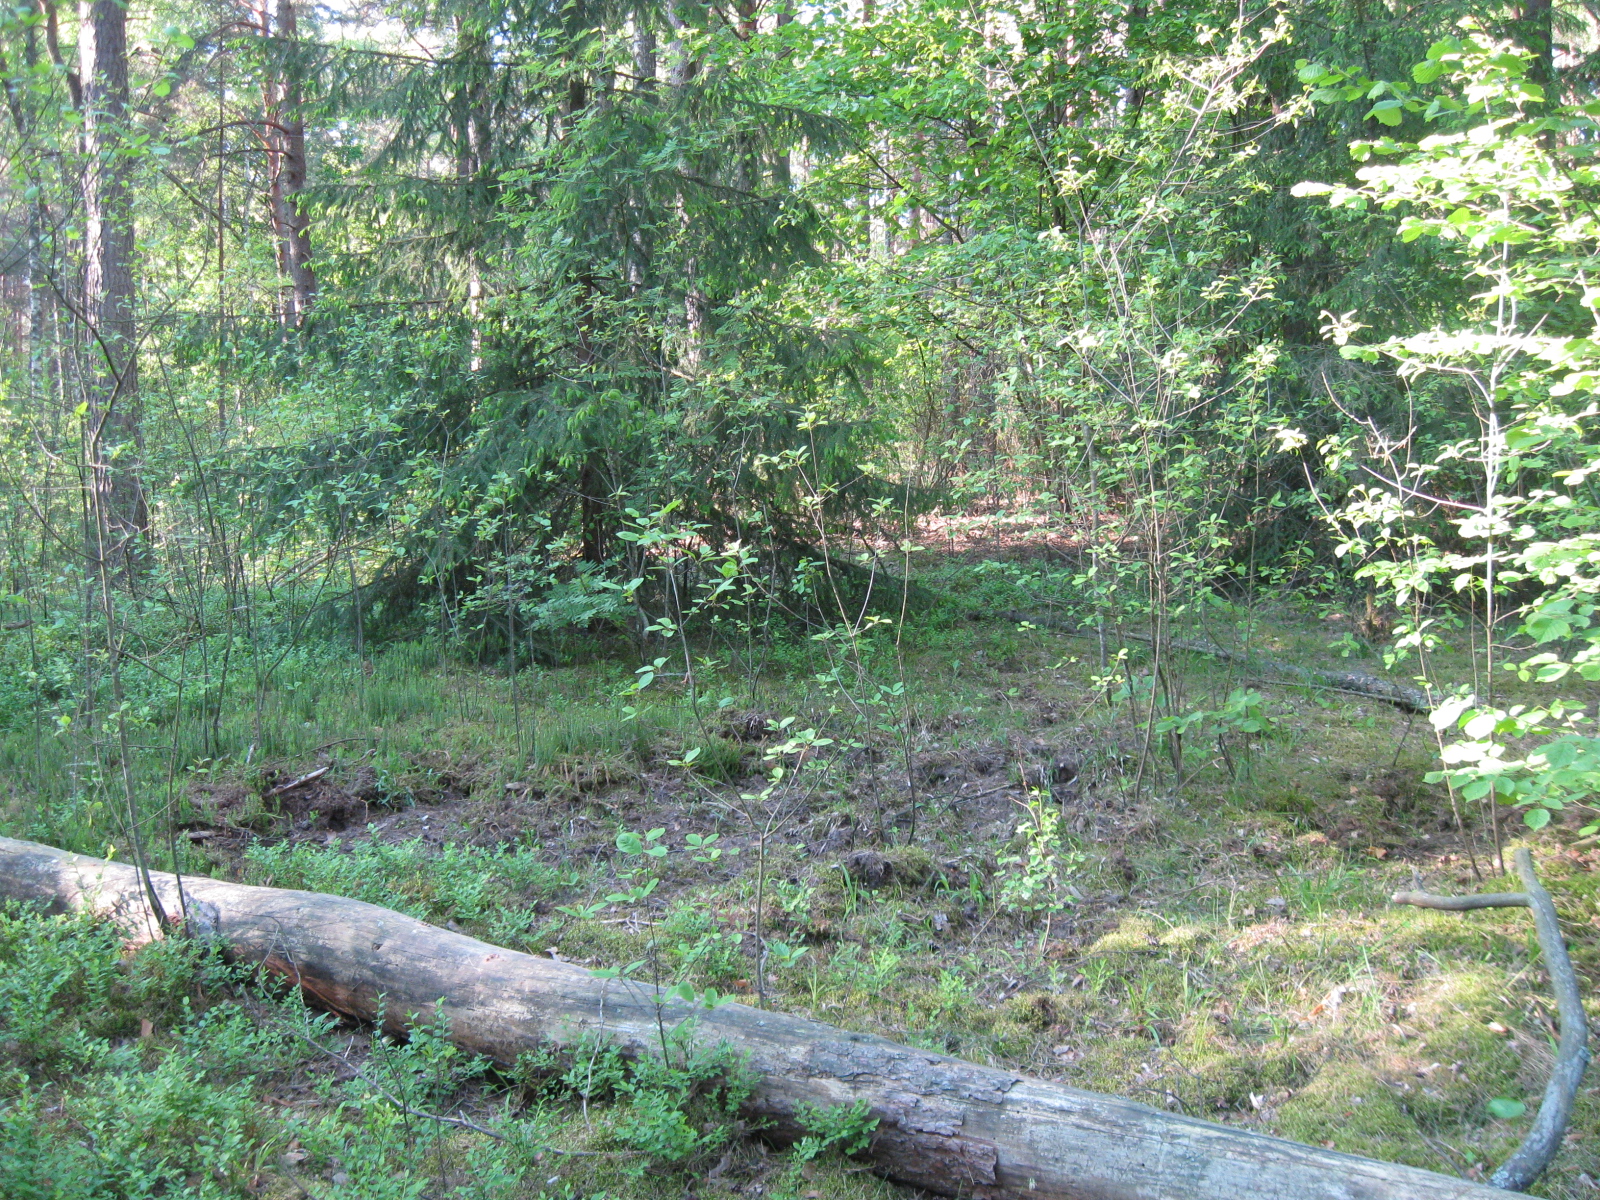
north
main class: Woodland
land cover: Pine dominated mixed woodland
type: hemiboreal forest and nemoral coniferous forest and mixed broadleaved-coniferous forest
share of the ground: > 75 %
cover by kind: coniferous forest trees 60 %, broadleaved forest trees 30 %, herbaceous plants 10 %
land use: Forestry
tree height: > 5 m
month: June
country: LT
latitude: 54.1308
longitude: 23.7227
